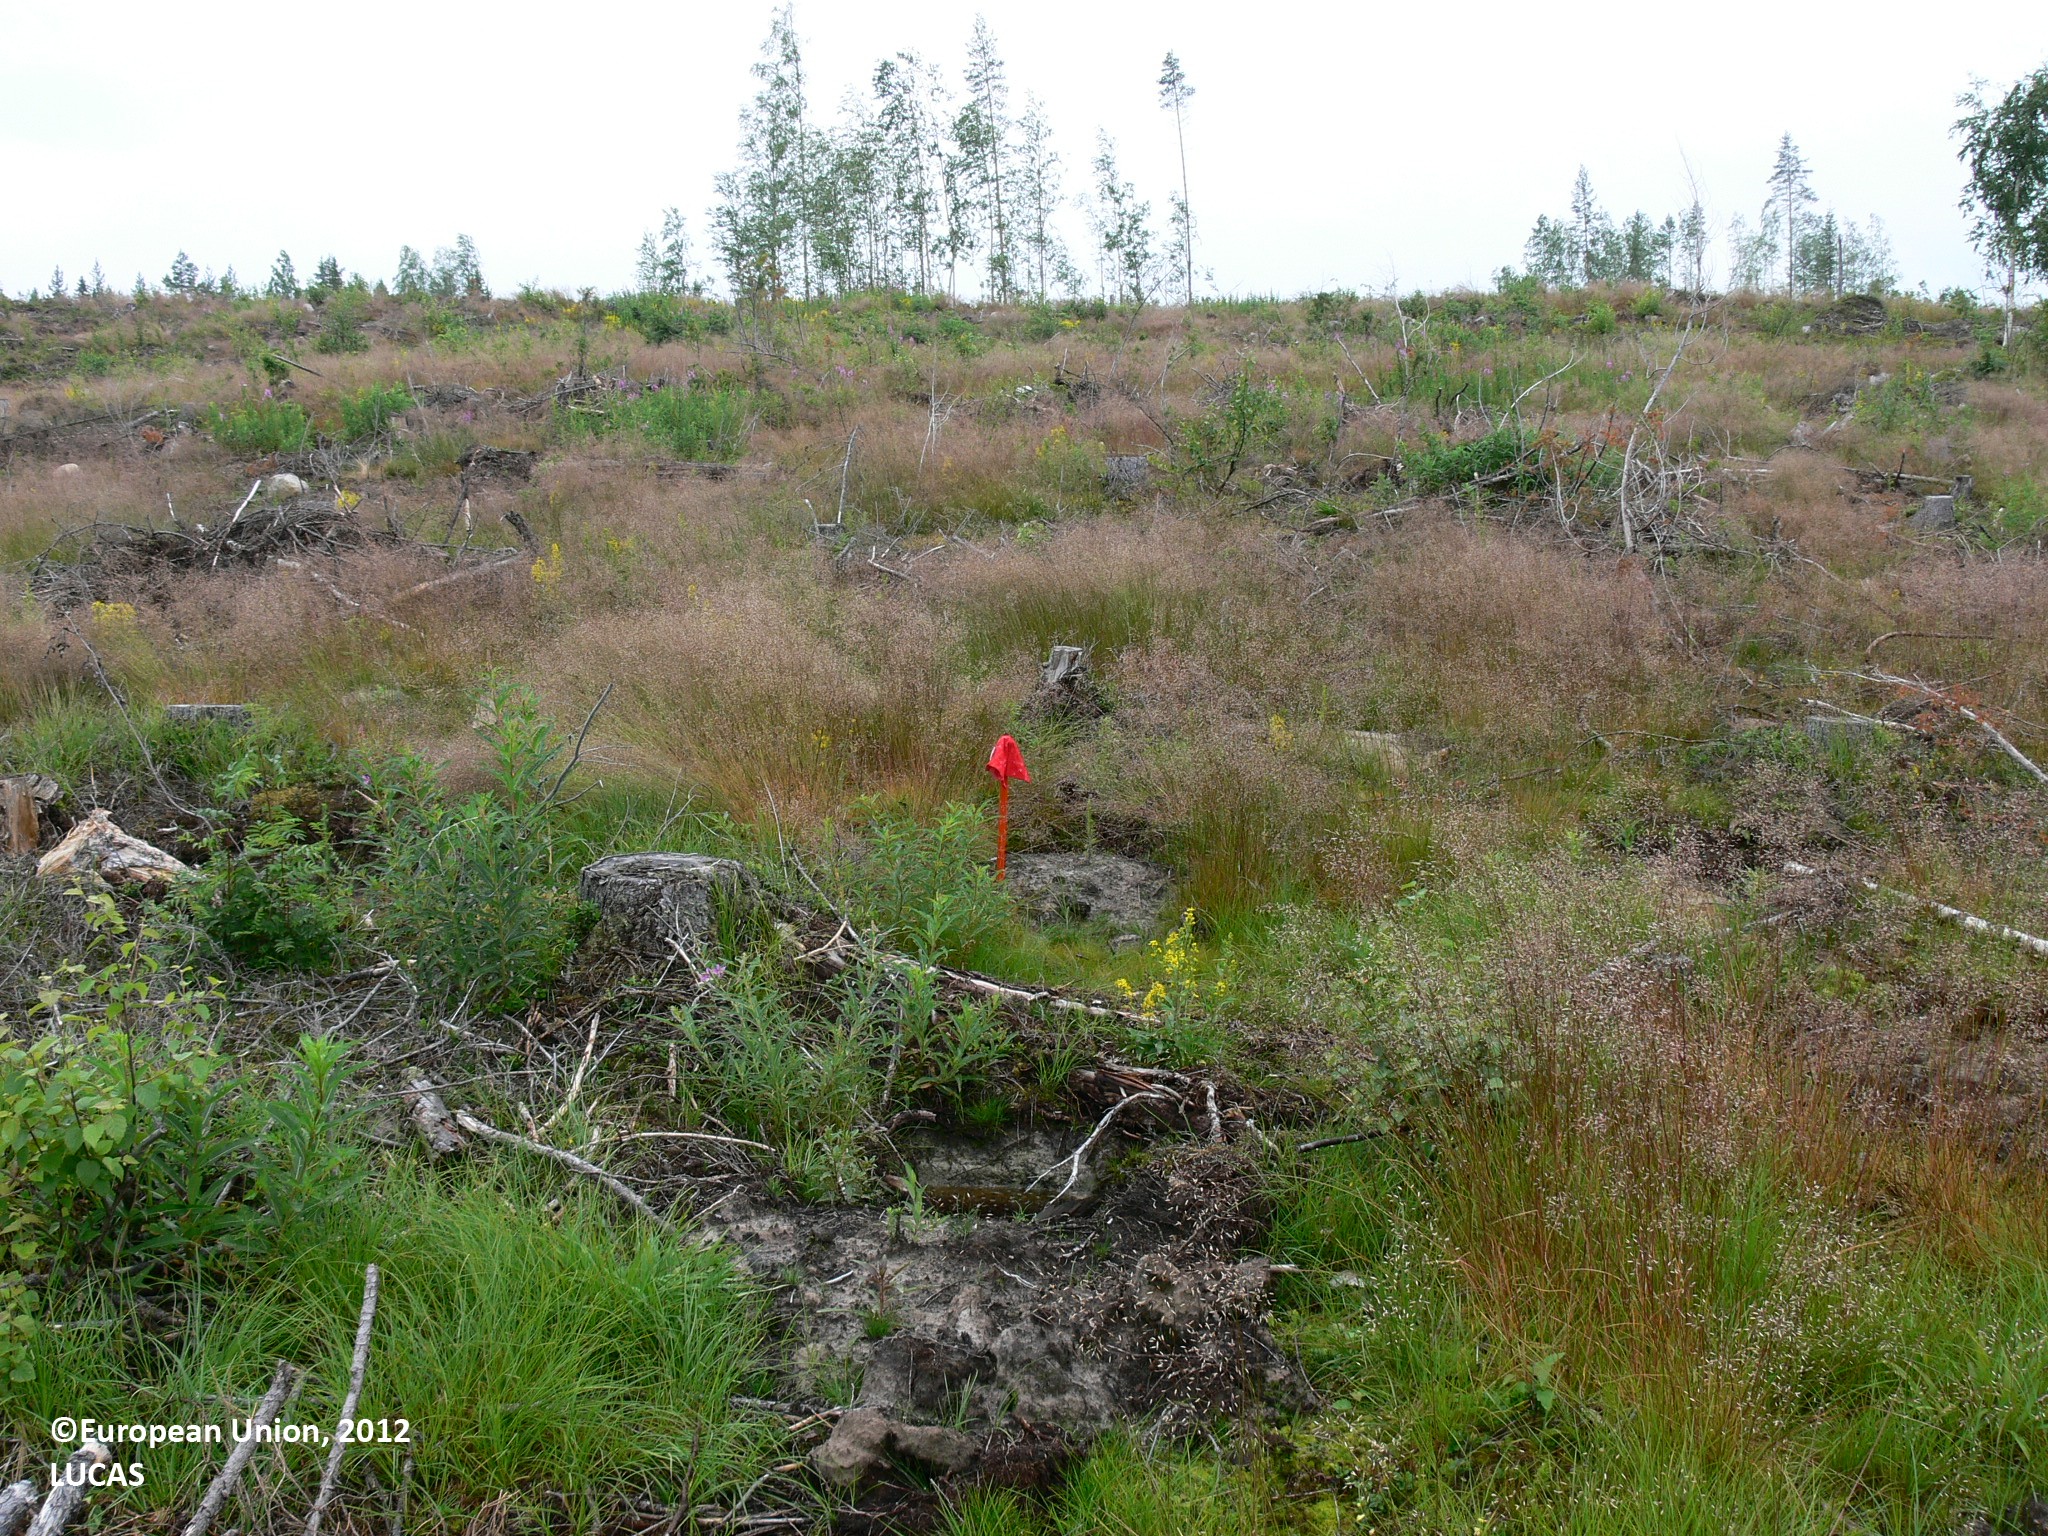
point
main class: Woodland
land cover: Pine dominated coniferous woodland
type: boreal forest
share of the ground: < 10 %
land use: Forestry
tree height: < 5 m
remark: Clear cut
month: July
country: FI
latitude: 63.1512
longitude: 30.8721
